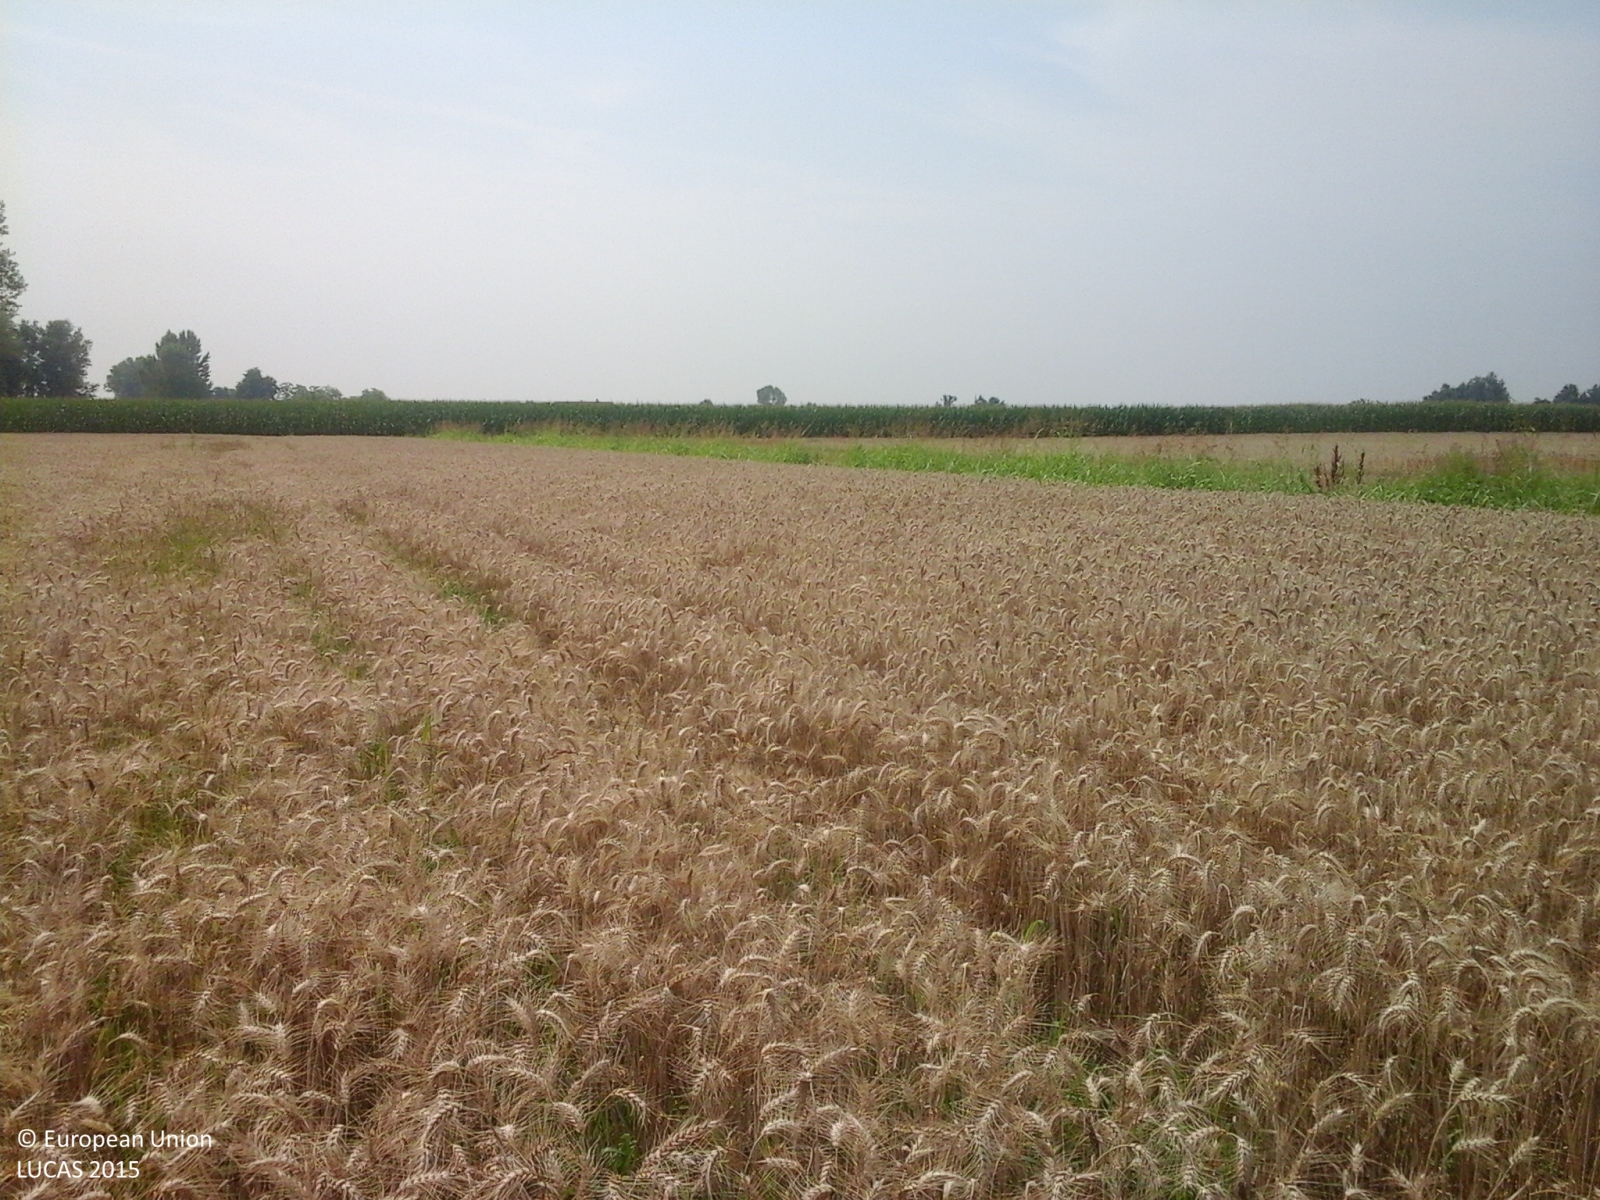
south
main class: Cropland
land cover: Common wheat
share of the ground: > 75 %
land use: Agriculture (excluding fallow land and kitchen gardens)
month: June
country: IT
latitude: 44.9539
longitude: 8.5704
